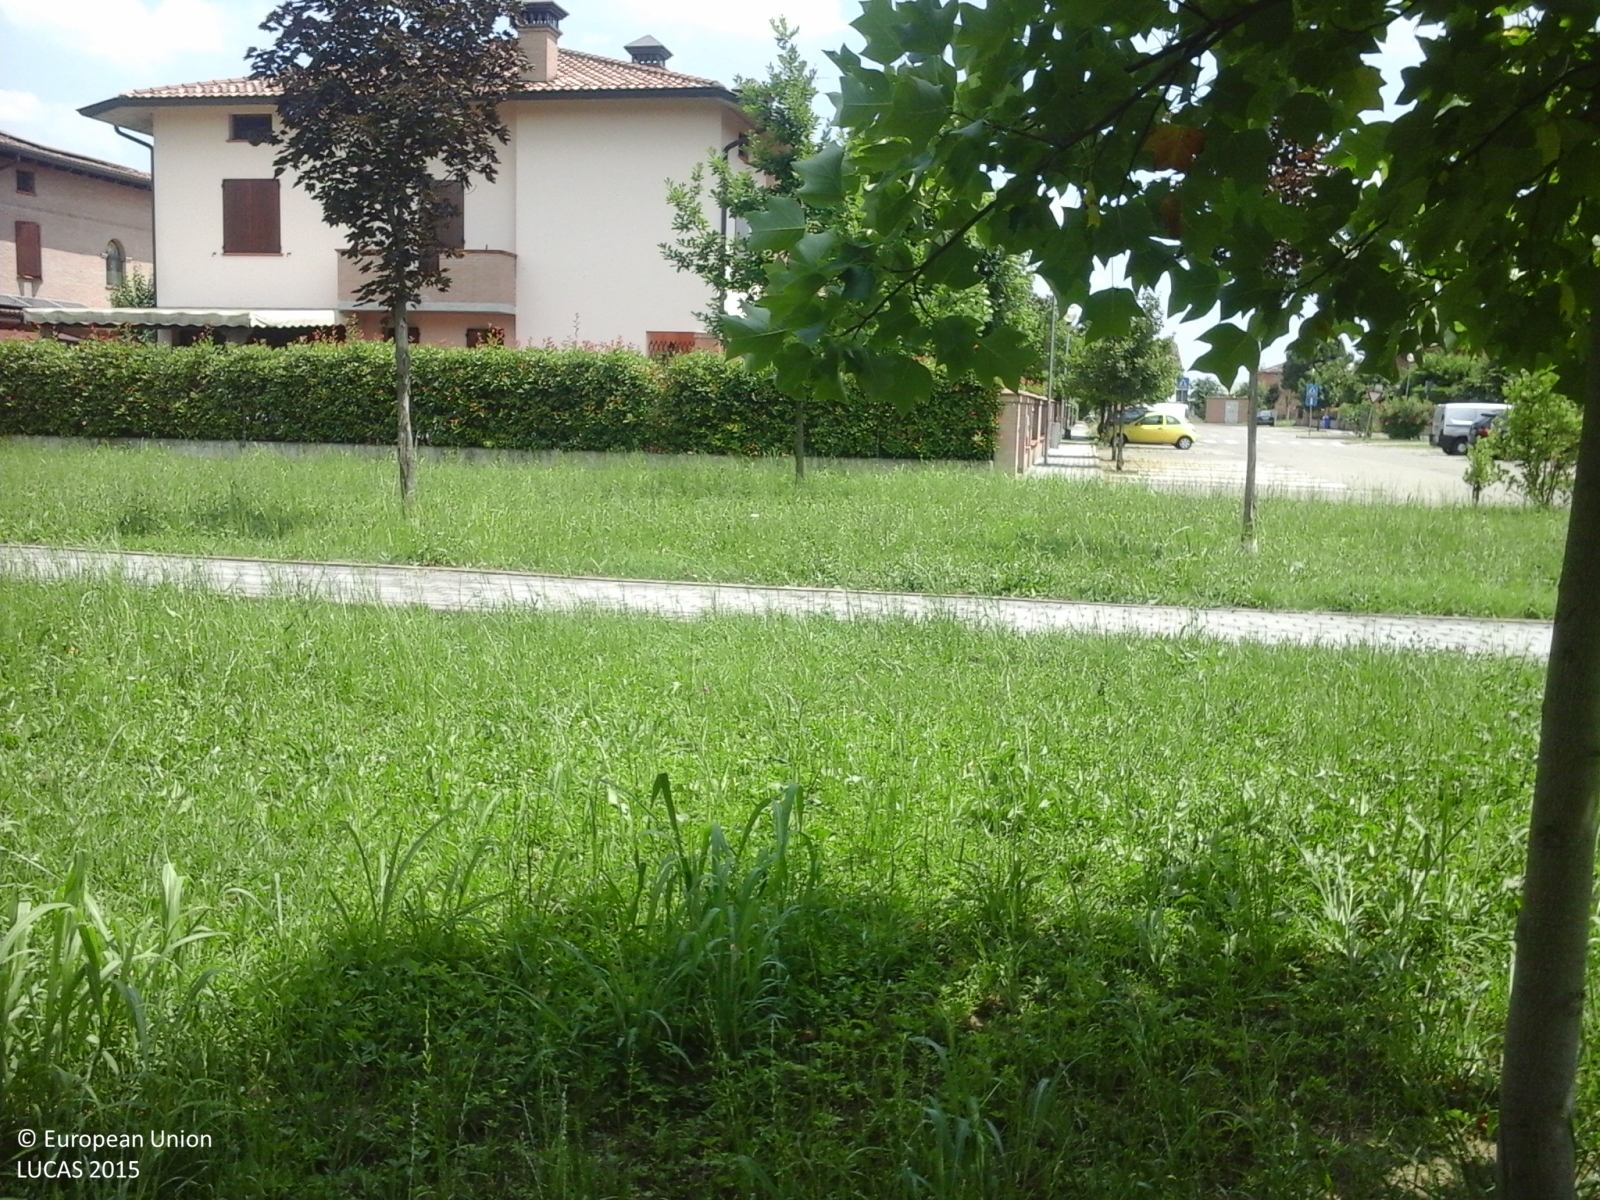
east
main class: Grassland
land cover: Grassland with sparse tree/shrub cover
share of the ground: > 75 %
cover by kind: herbaceous plants 95 %, broadleaved forest trees 5 %
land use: Residential
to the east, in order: Grassland with sparse tree/shrub cover; Artificial constructions in urban areas
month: June
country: IT
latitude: 44.7613
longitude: 10.9203
